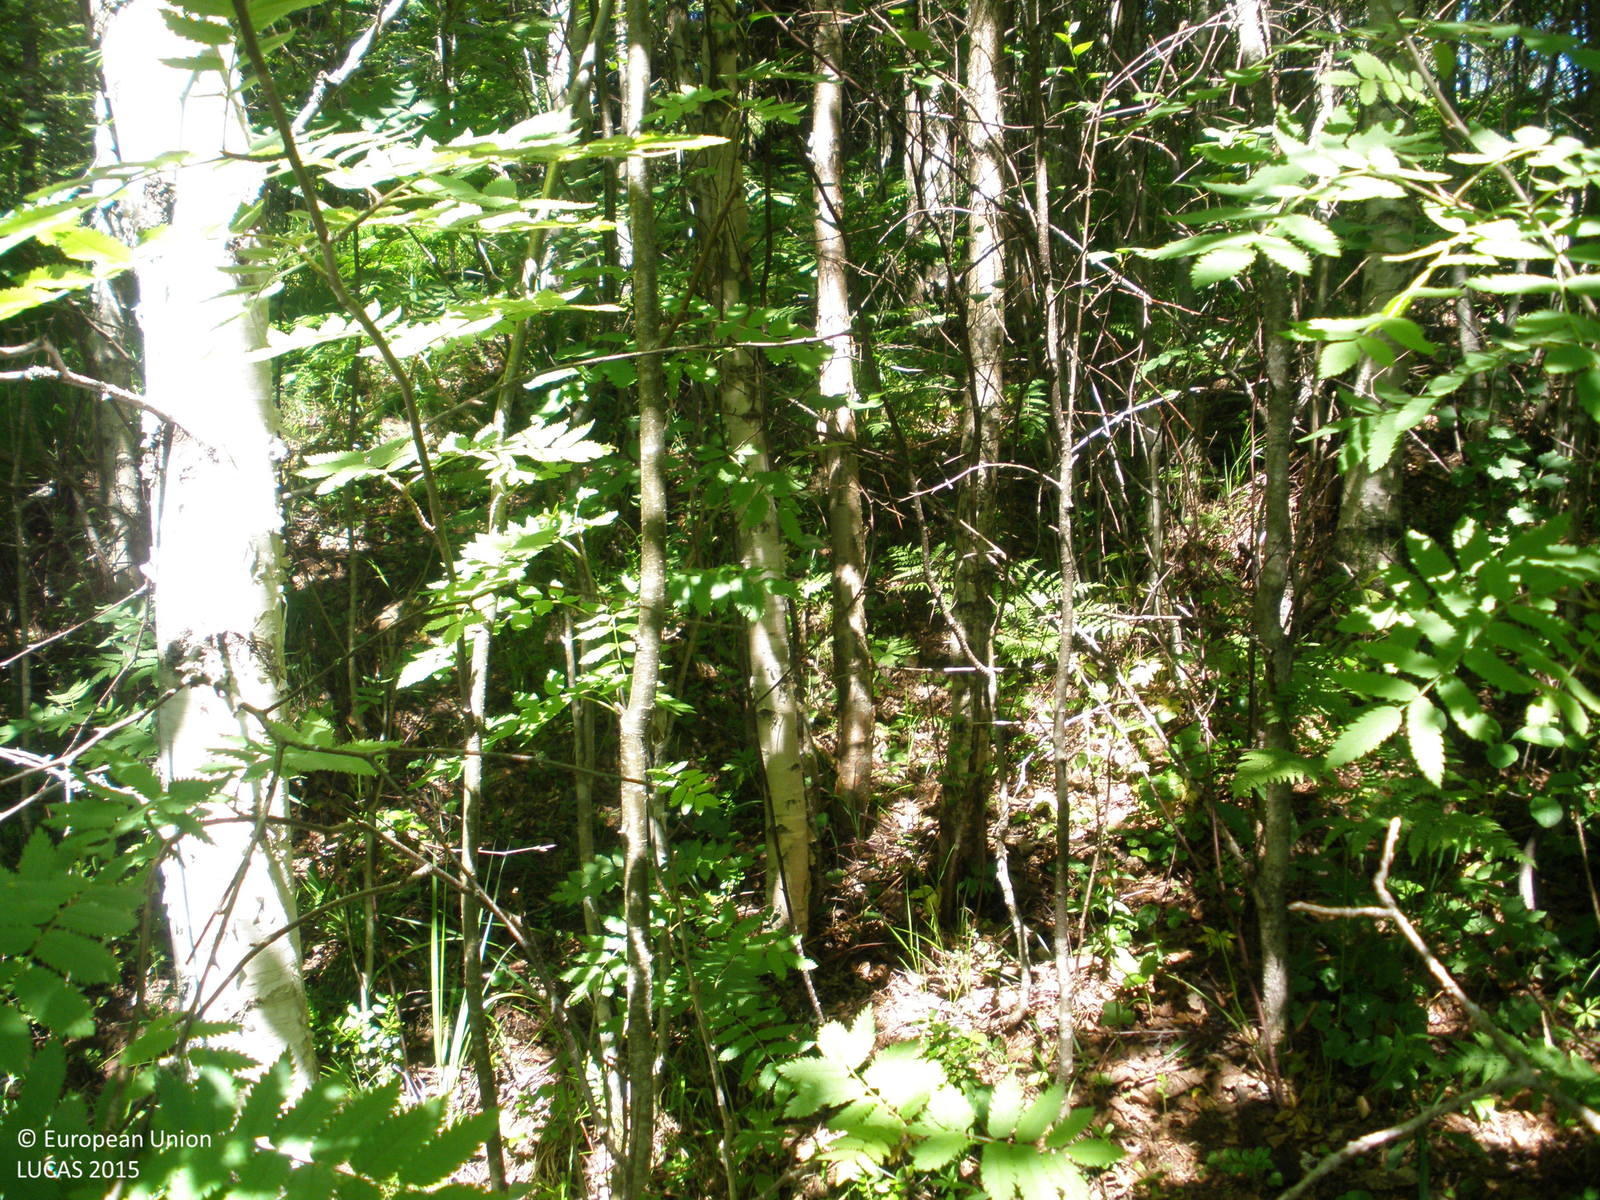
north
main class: Woodland
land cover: Broadleaved woodland
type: non-riverine alder, birch or aspen forest
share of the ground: > 75 %
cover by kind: broadleaved forest trees 85 %, herbaceous plants 15 %
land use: Forestry
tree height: > 5 m
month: July
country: FI
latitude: 61.0401
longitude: 23.7697
